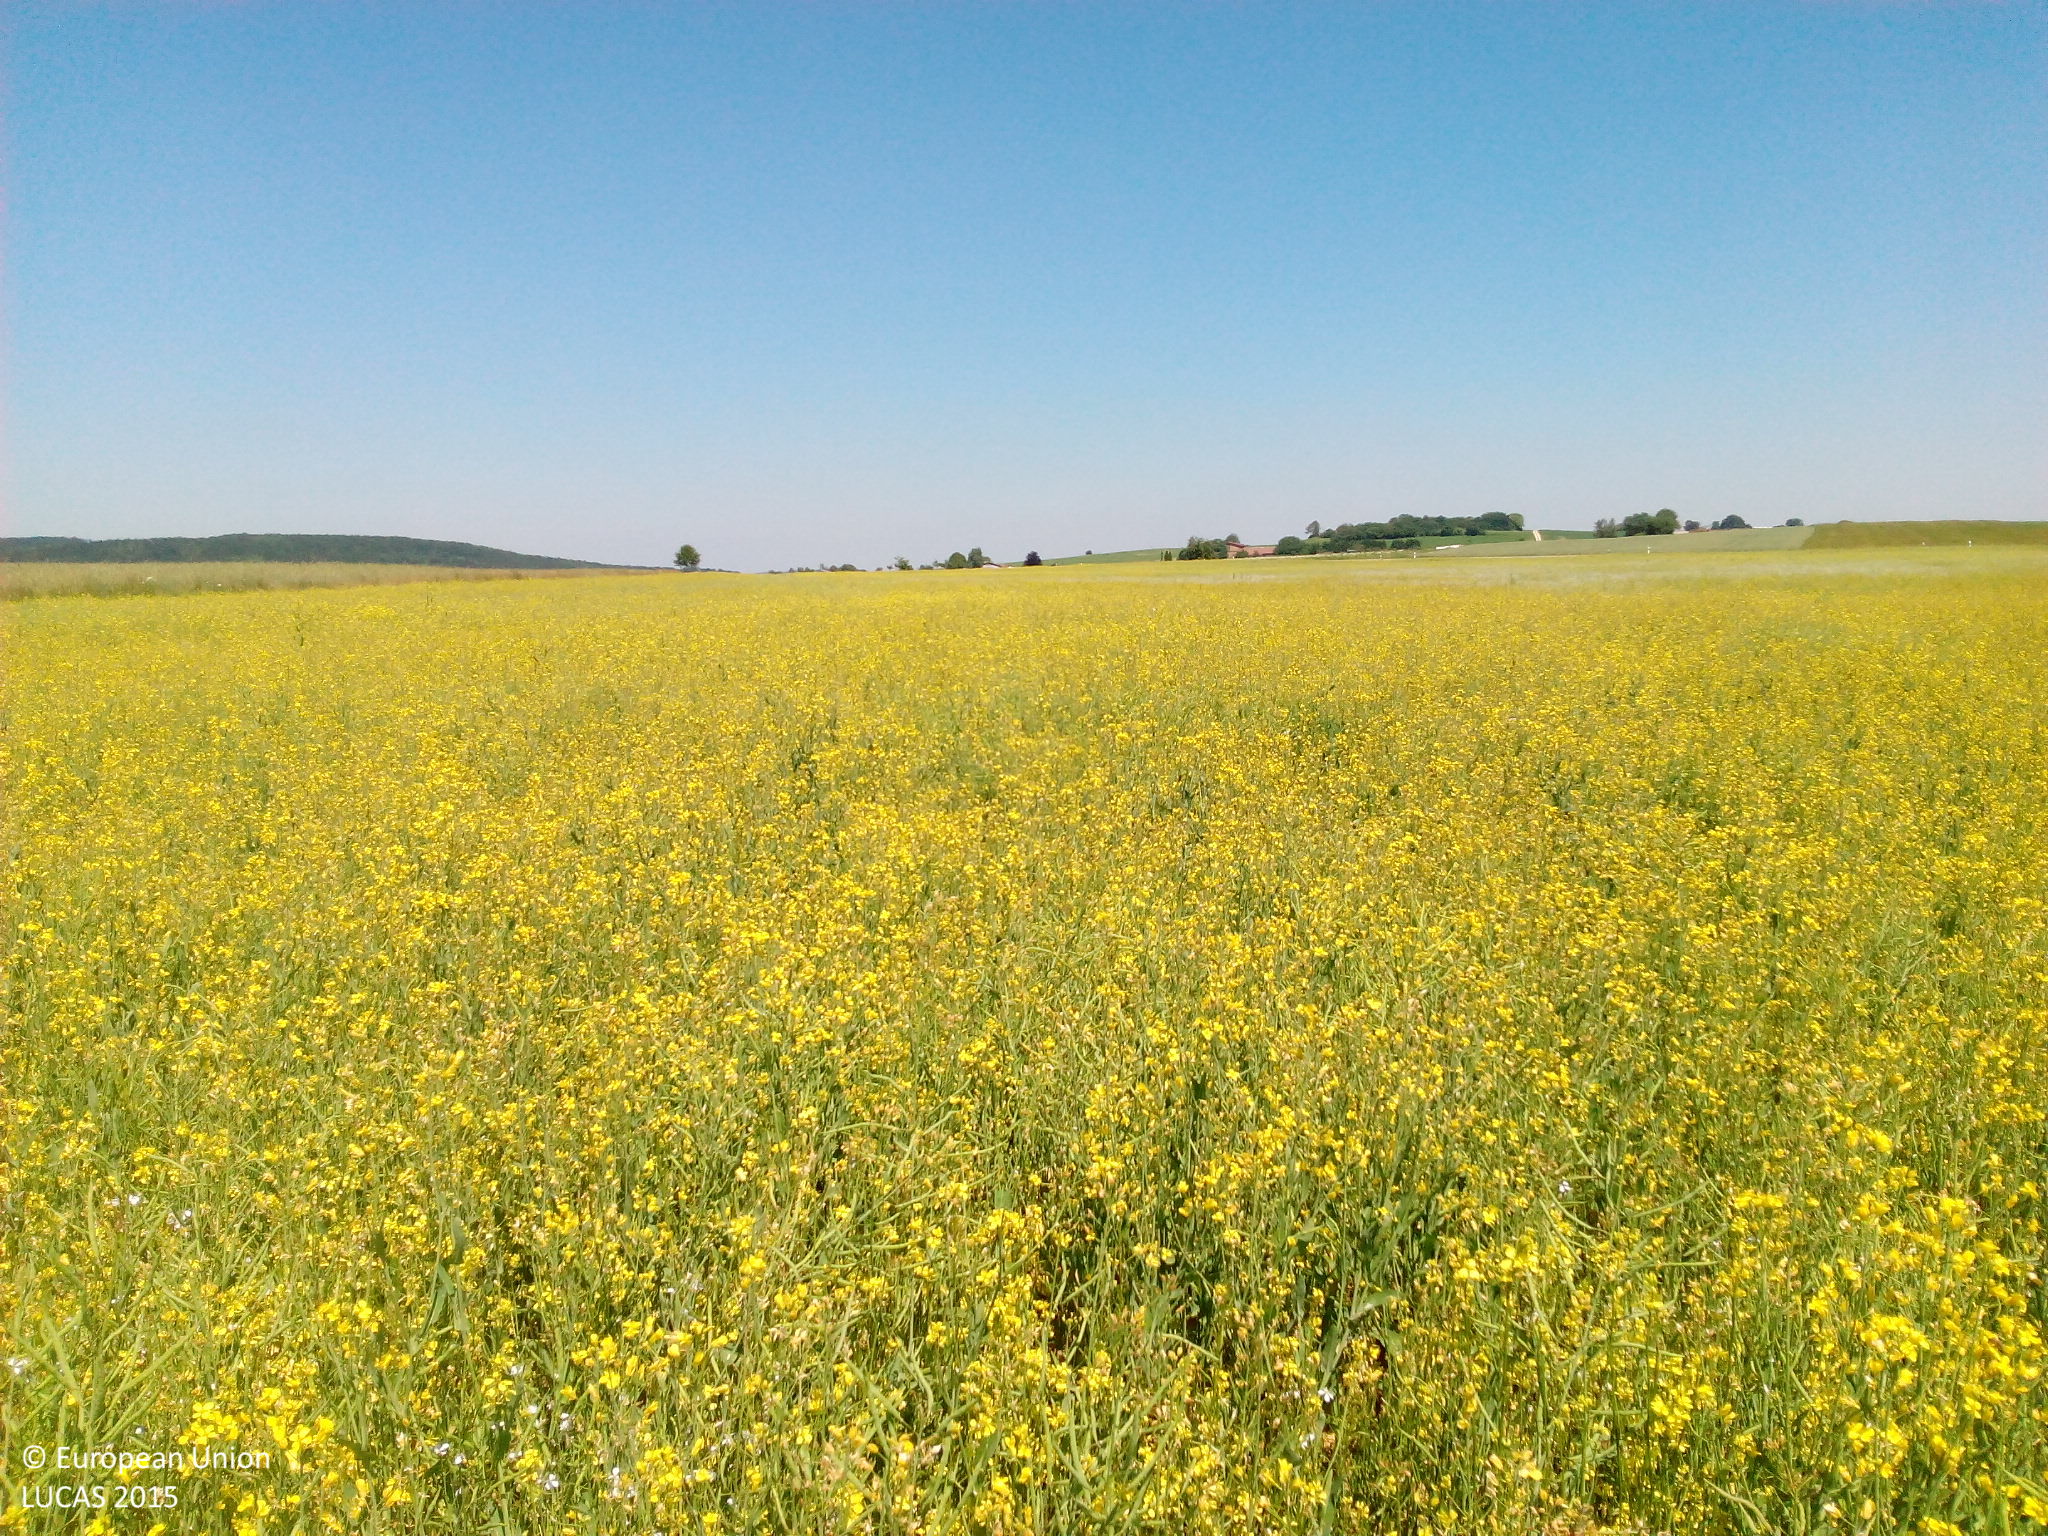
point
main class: Cropland
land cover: Rape and turnip rape
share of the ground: > 75 %
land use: Agriculture (excluding fallow land and kitchen gardens)
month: July
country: DE
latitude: 48.3120
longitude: 9.4205
